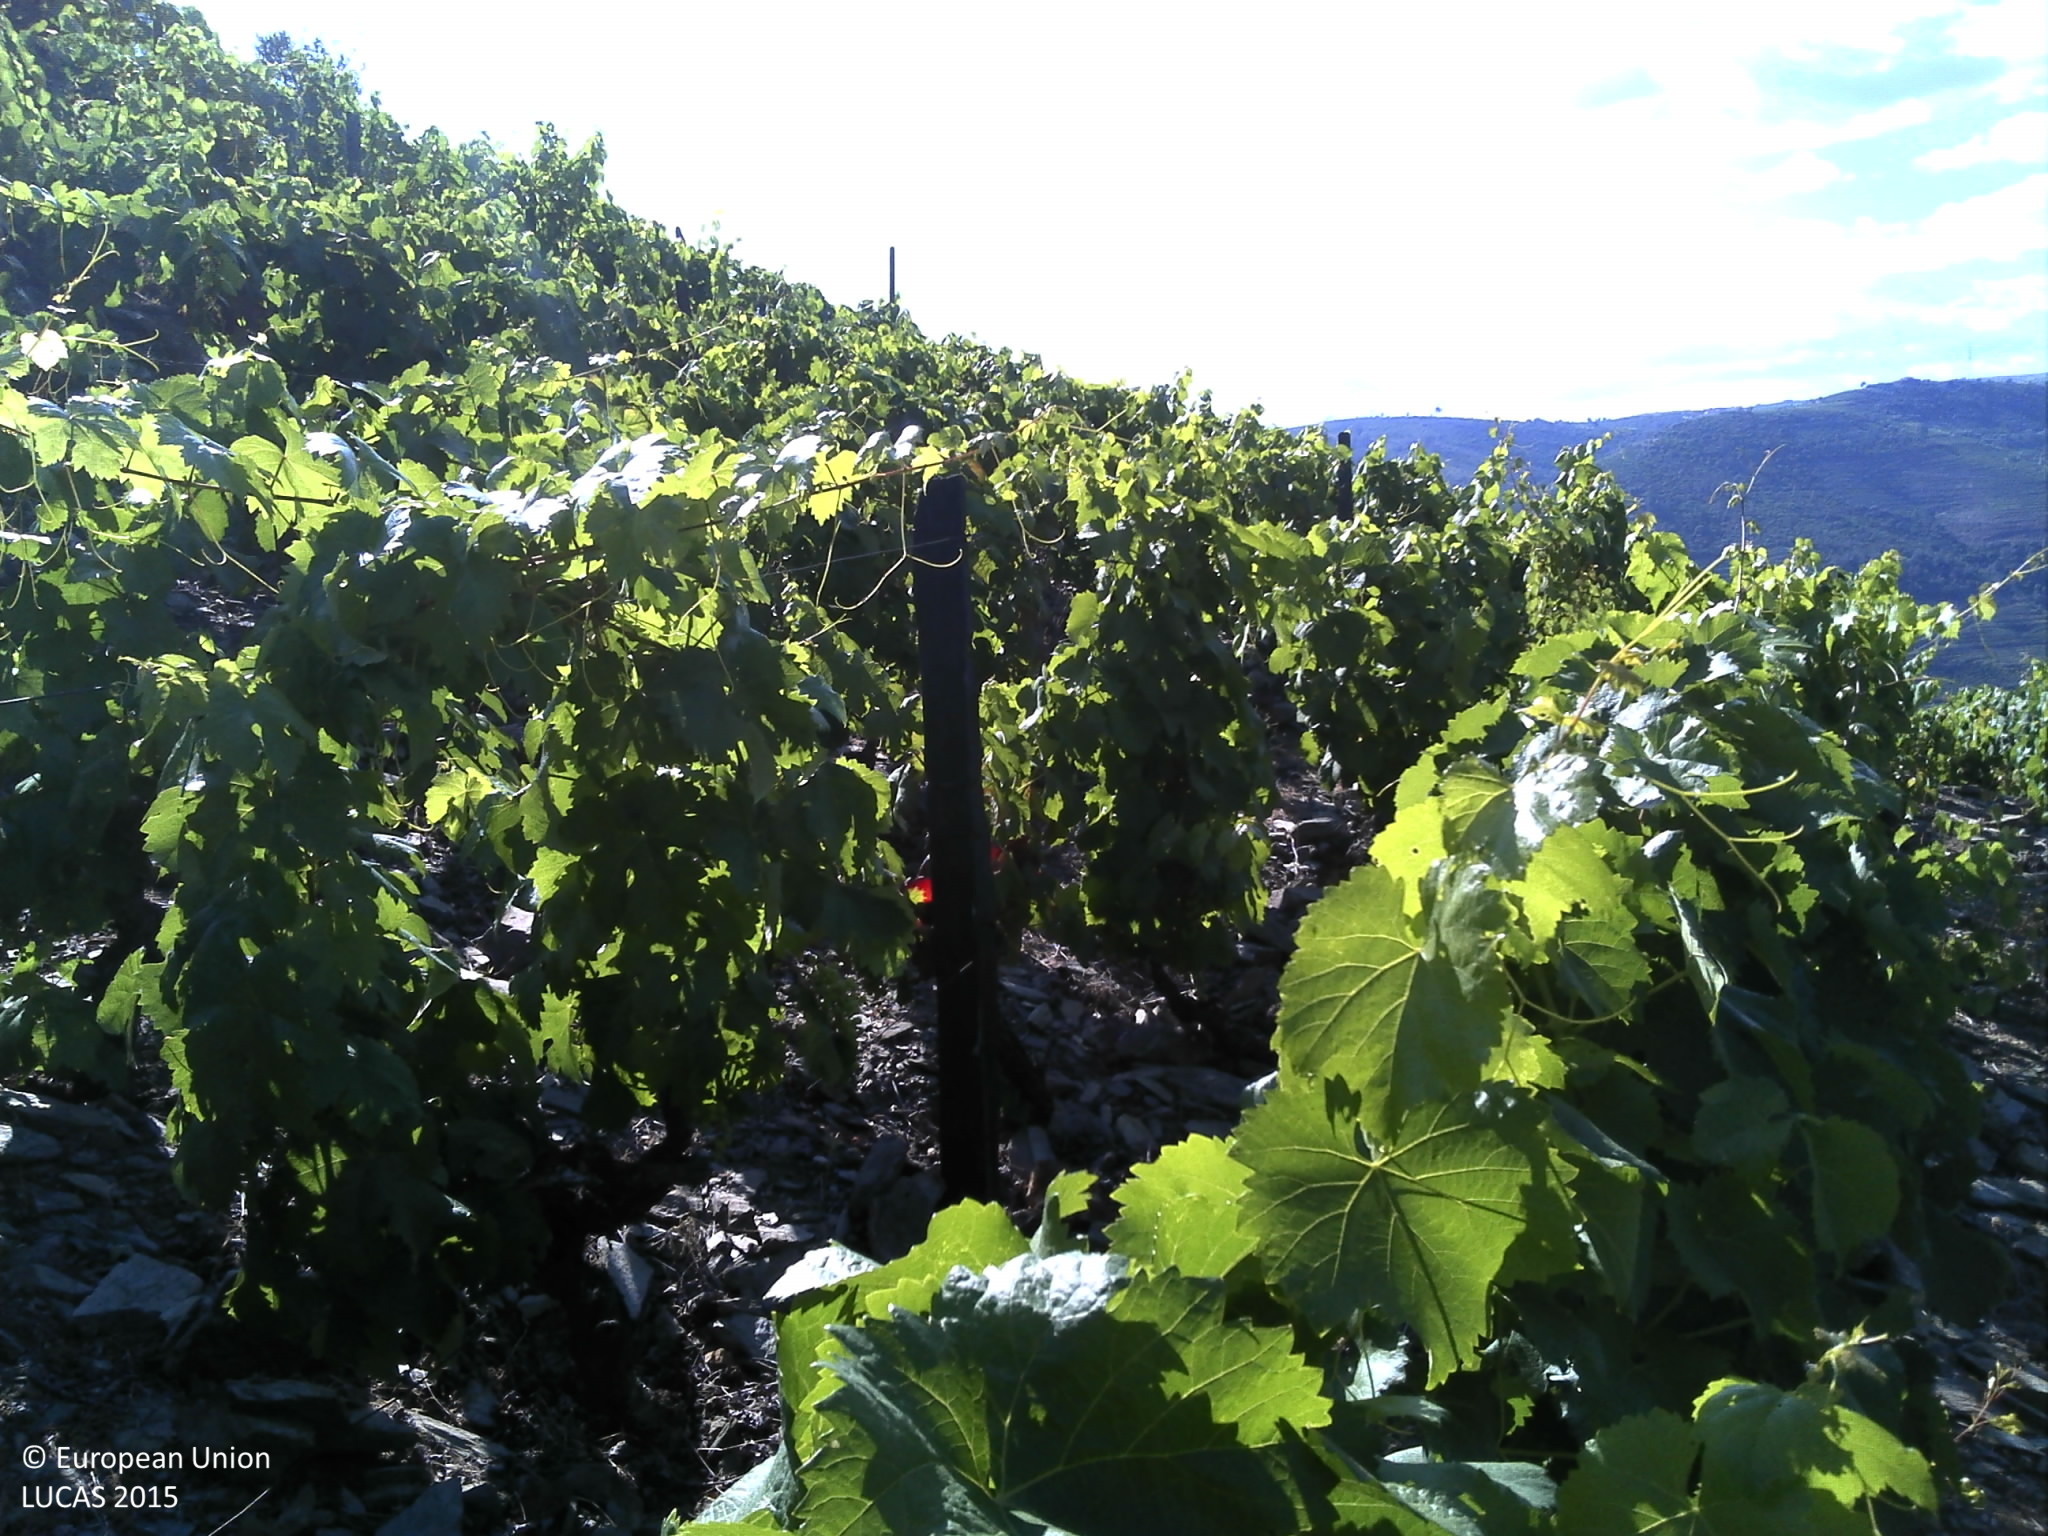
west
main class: Cropland
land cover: Vineyards
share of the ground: 10 - 25 %
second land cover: Other bare soil
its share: > 75 %
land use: Agriculture (excluding fallow land and kitchen gardens)
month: June
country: PT
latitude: 41.1403
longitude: -7.6751
